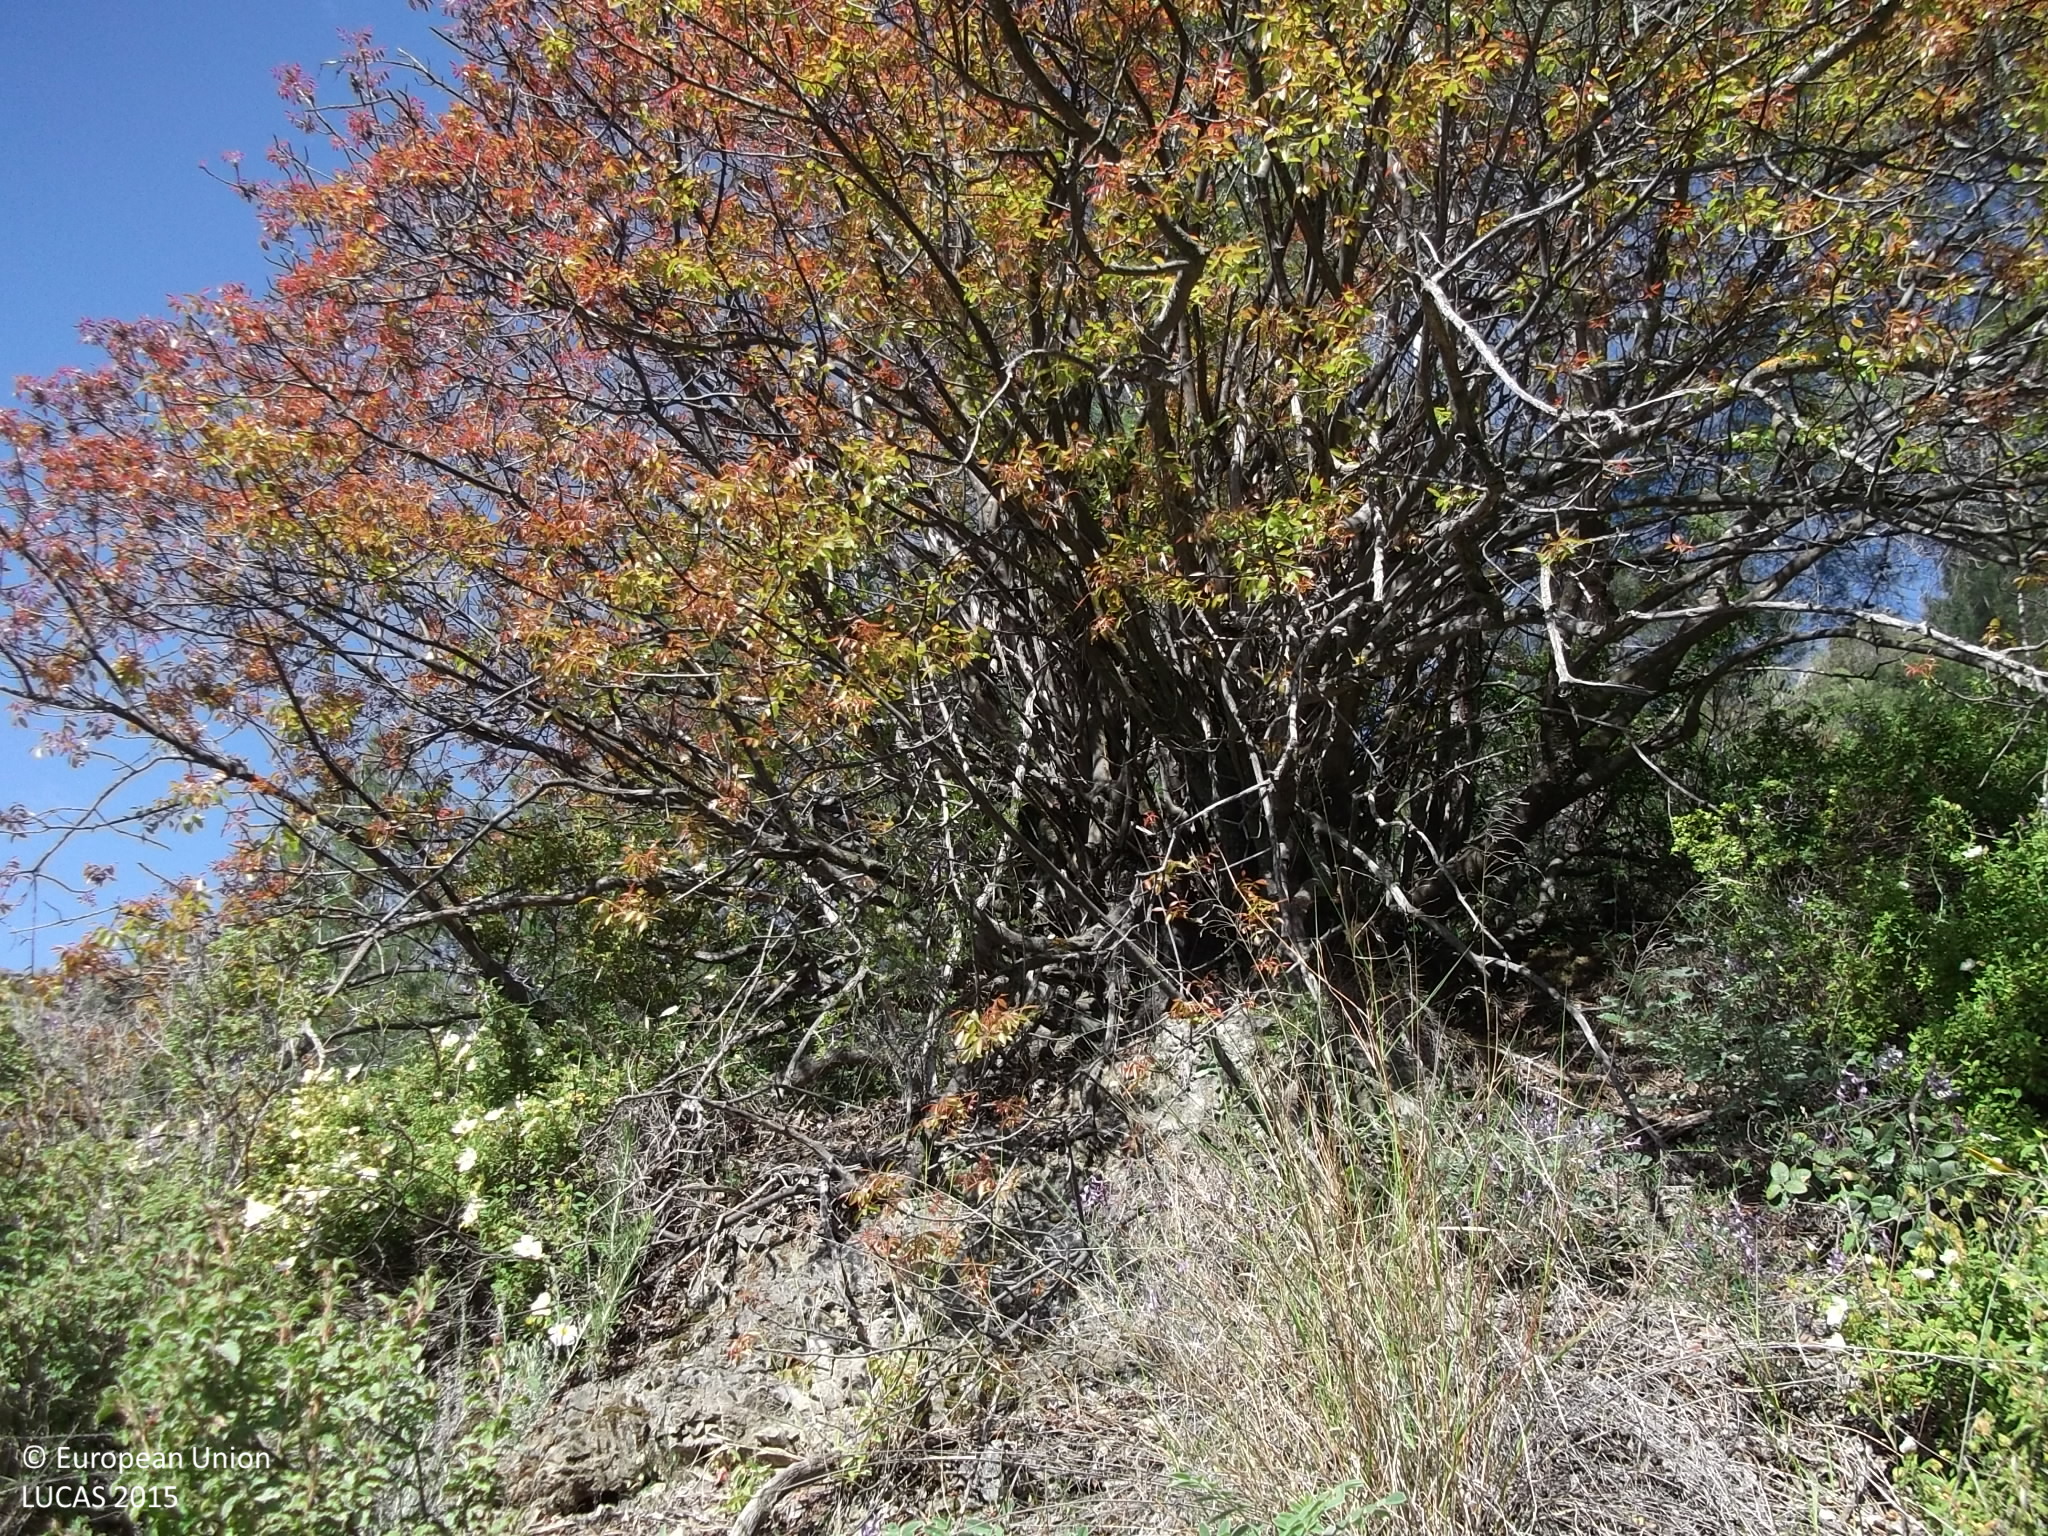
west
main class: Woodland
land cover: Pine dominated coniferous woodland
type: coniferous forest of the mediterranean region
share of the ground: 25 - 50 %
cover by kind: shrubs 50 %, coniferous forest trees 30 %, consolidated bare surface 10 %, unconsolidated bare surface 10 %
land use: Semi-natural and natural areas not in use
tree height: > 5 m
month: April
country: CY
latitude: 34.8821
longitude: 33.0952
